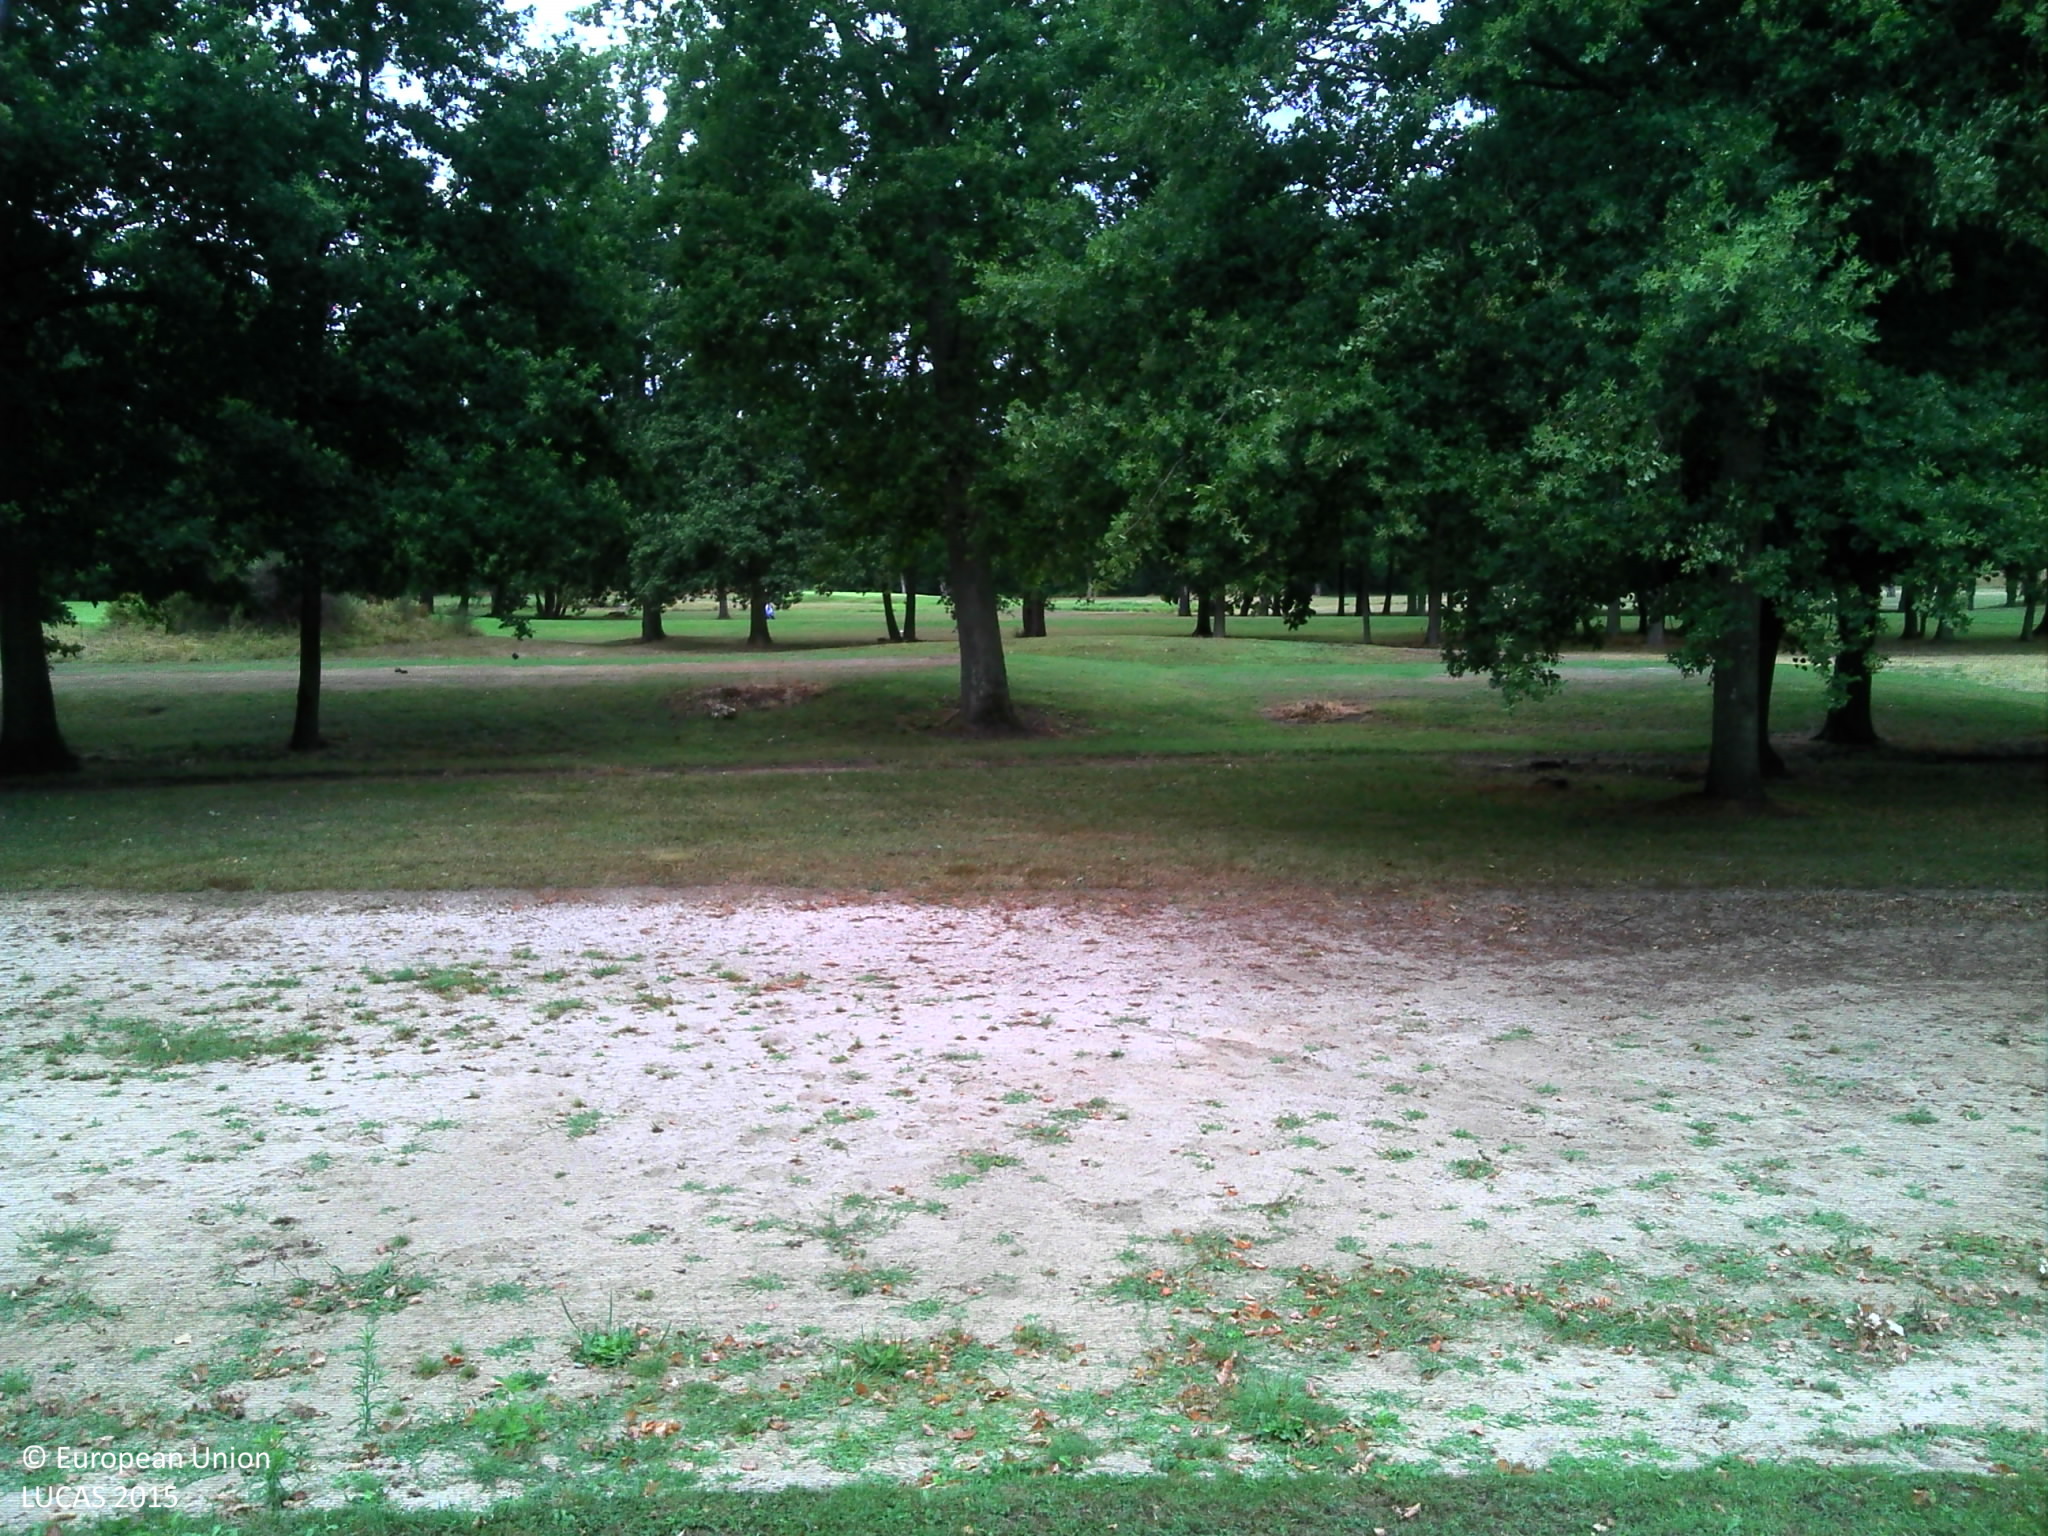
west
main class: Grassland
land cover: Grassland without tree/shrub cover
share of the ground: > 75 %
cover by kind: herbaceous plants 70 %, lichens and mosses 5 %
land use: Sport
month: July
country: FR
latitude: 48.7411
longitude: 2.7149
